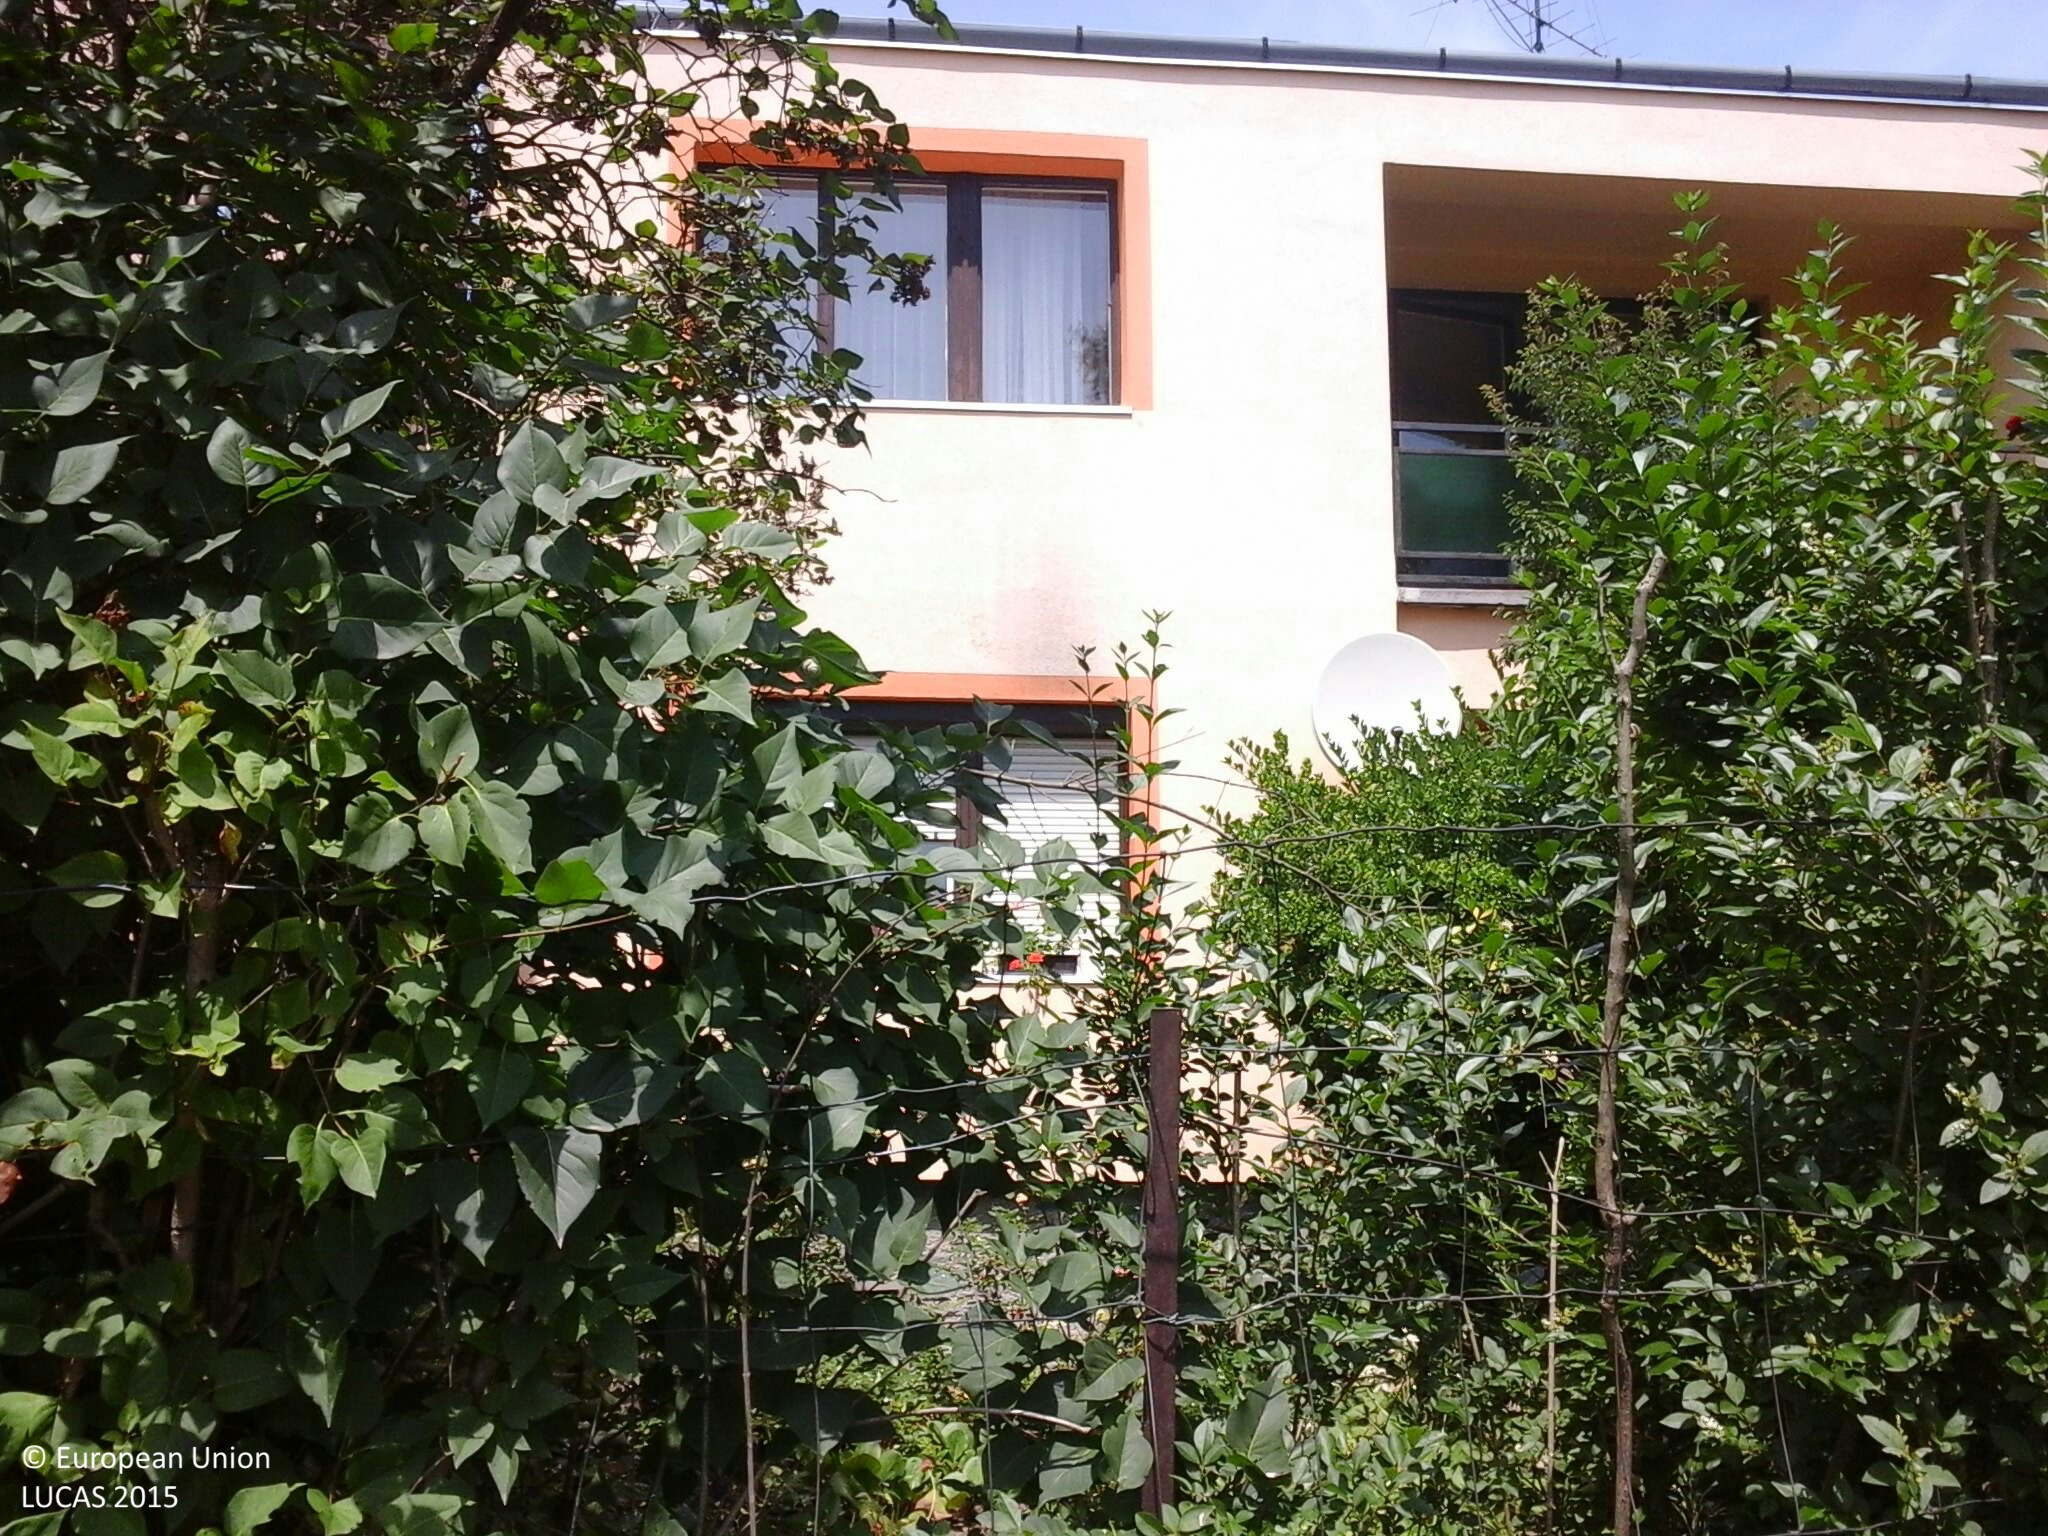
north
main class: Cropland
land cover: Floriculture and ornamental plants
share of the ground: 50 - 75 %
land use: Residential
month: June
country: HU
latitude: 46.8870
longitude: 17.4470
